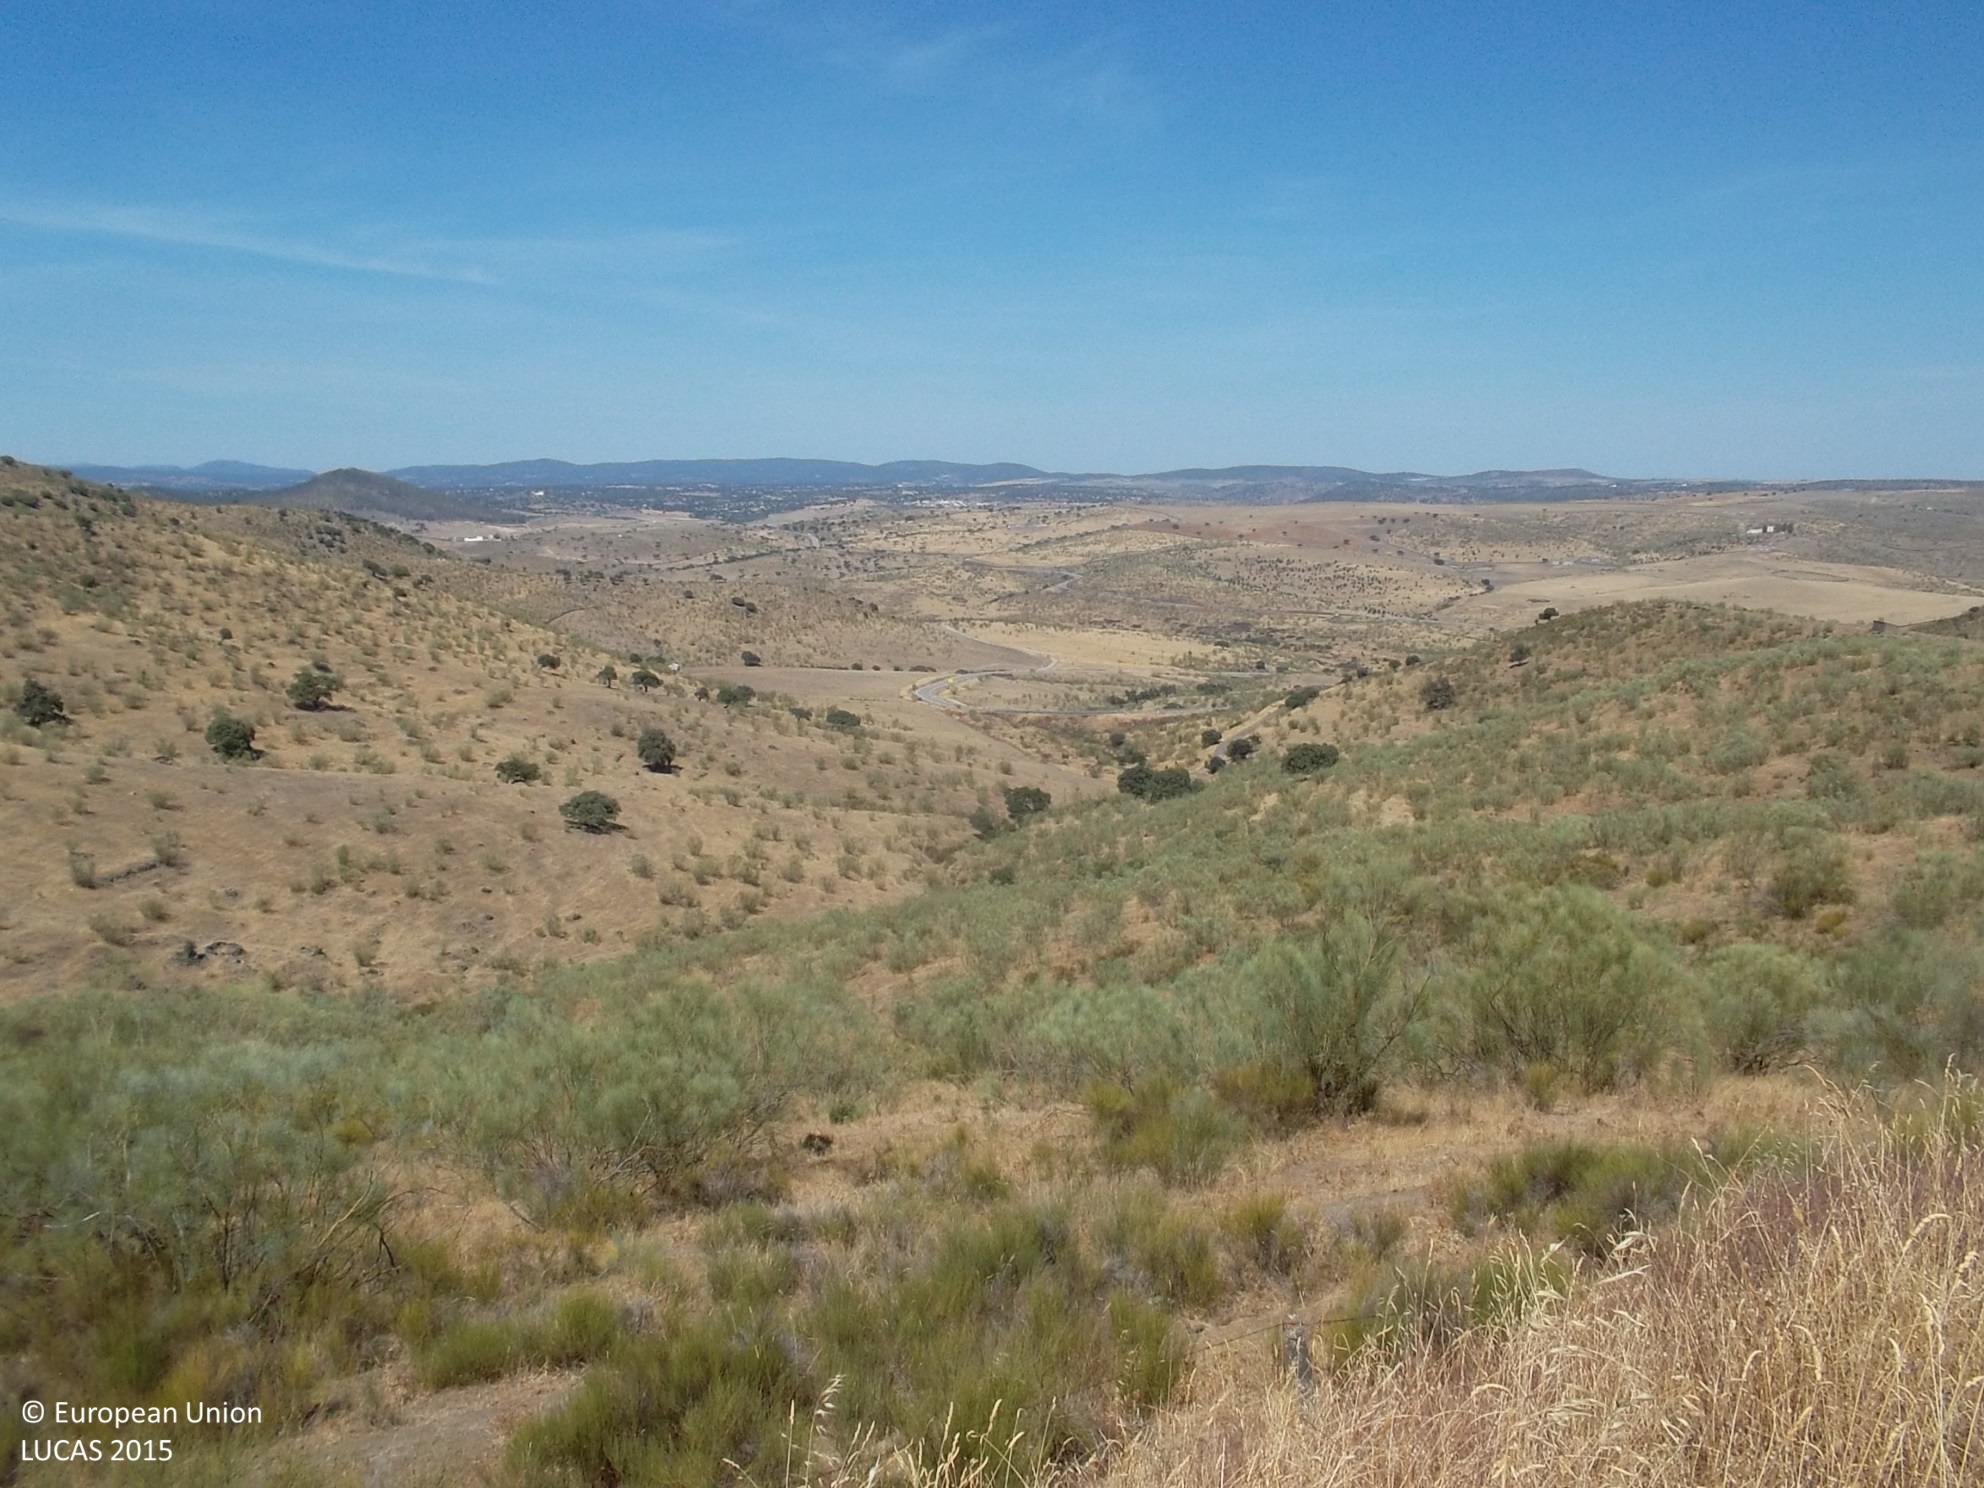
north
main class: Shrubland
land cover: Shrubland with sparse tree cover
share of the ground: 50 - 75 %
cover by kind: shrubs 55 %, herbaceous plants 40 %, broadleaved forest trees 5 %
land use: Semi-natural and natural areas not in use
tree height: < 5 m
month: August
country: ES
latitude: 38.2761
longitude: -6.5684
